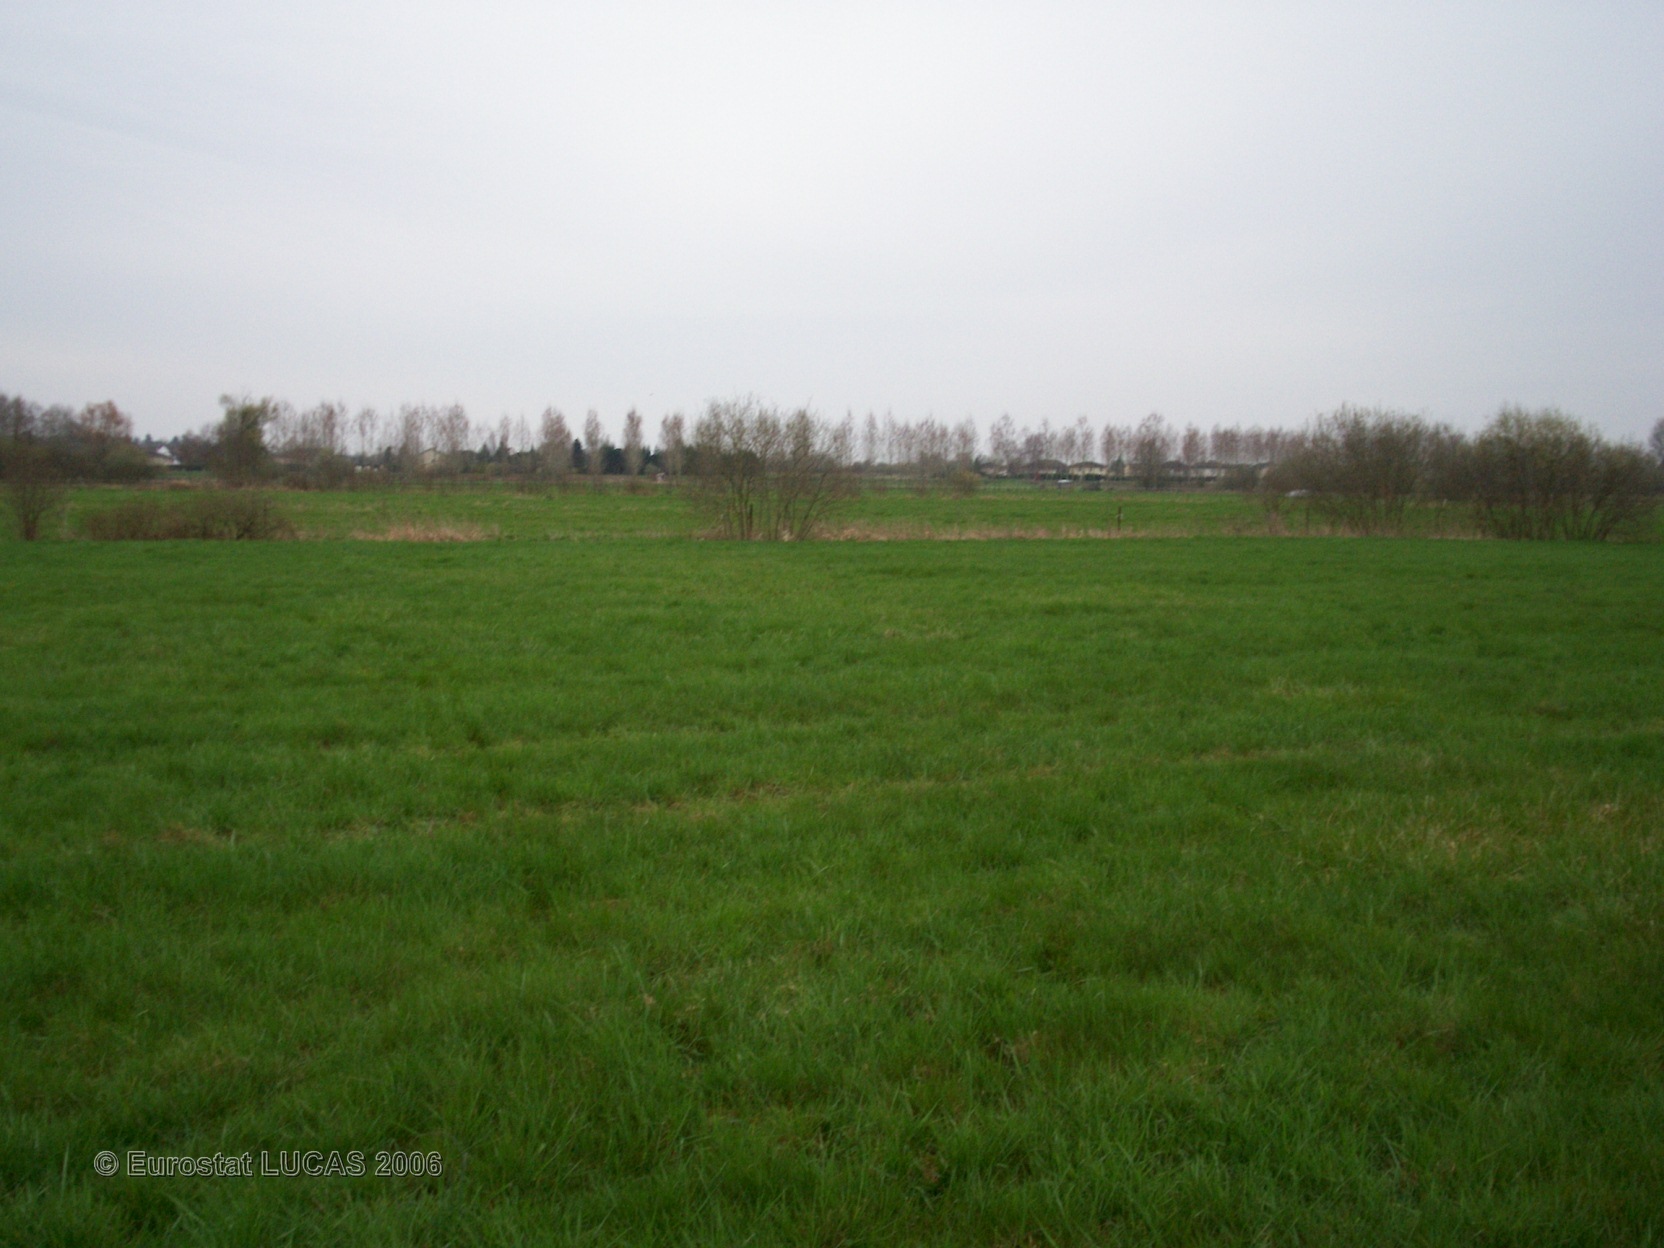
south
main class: Grassland
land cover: Grassland without tree/shrub cover
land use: Agriculture (excluding fallow land and kitchen gardens)
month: April
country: FR
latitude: 48.6016
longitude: 6.5424
